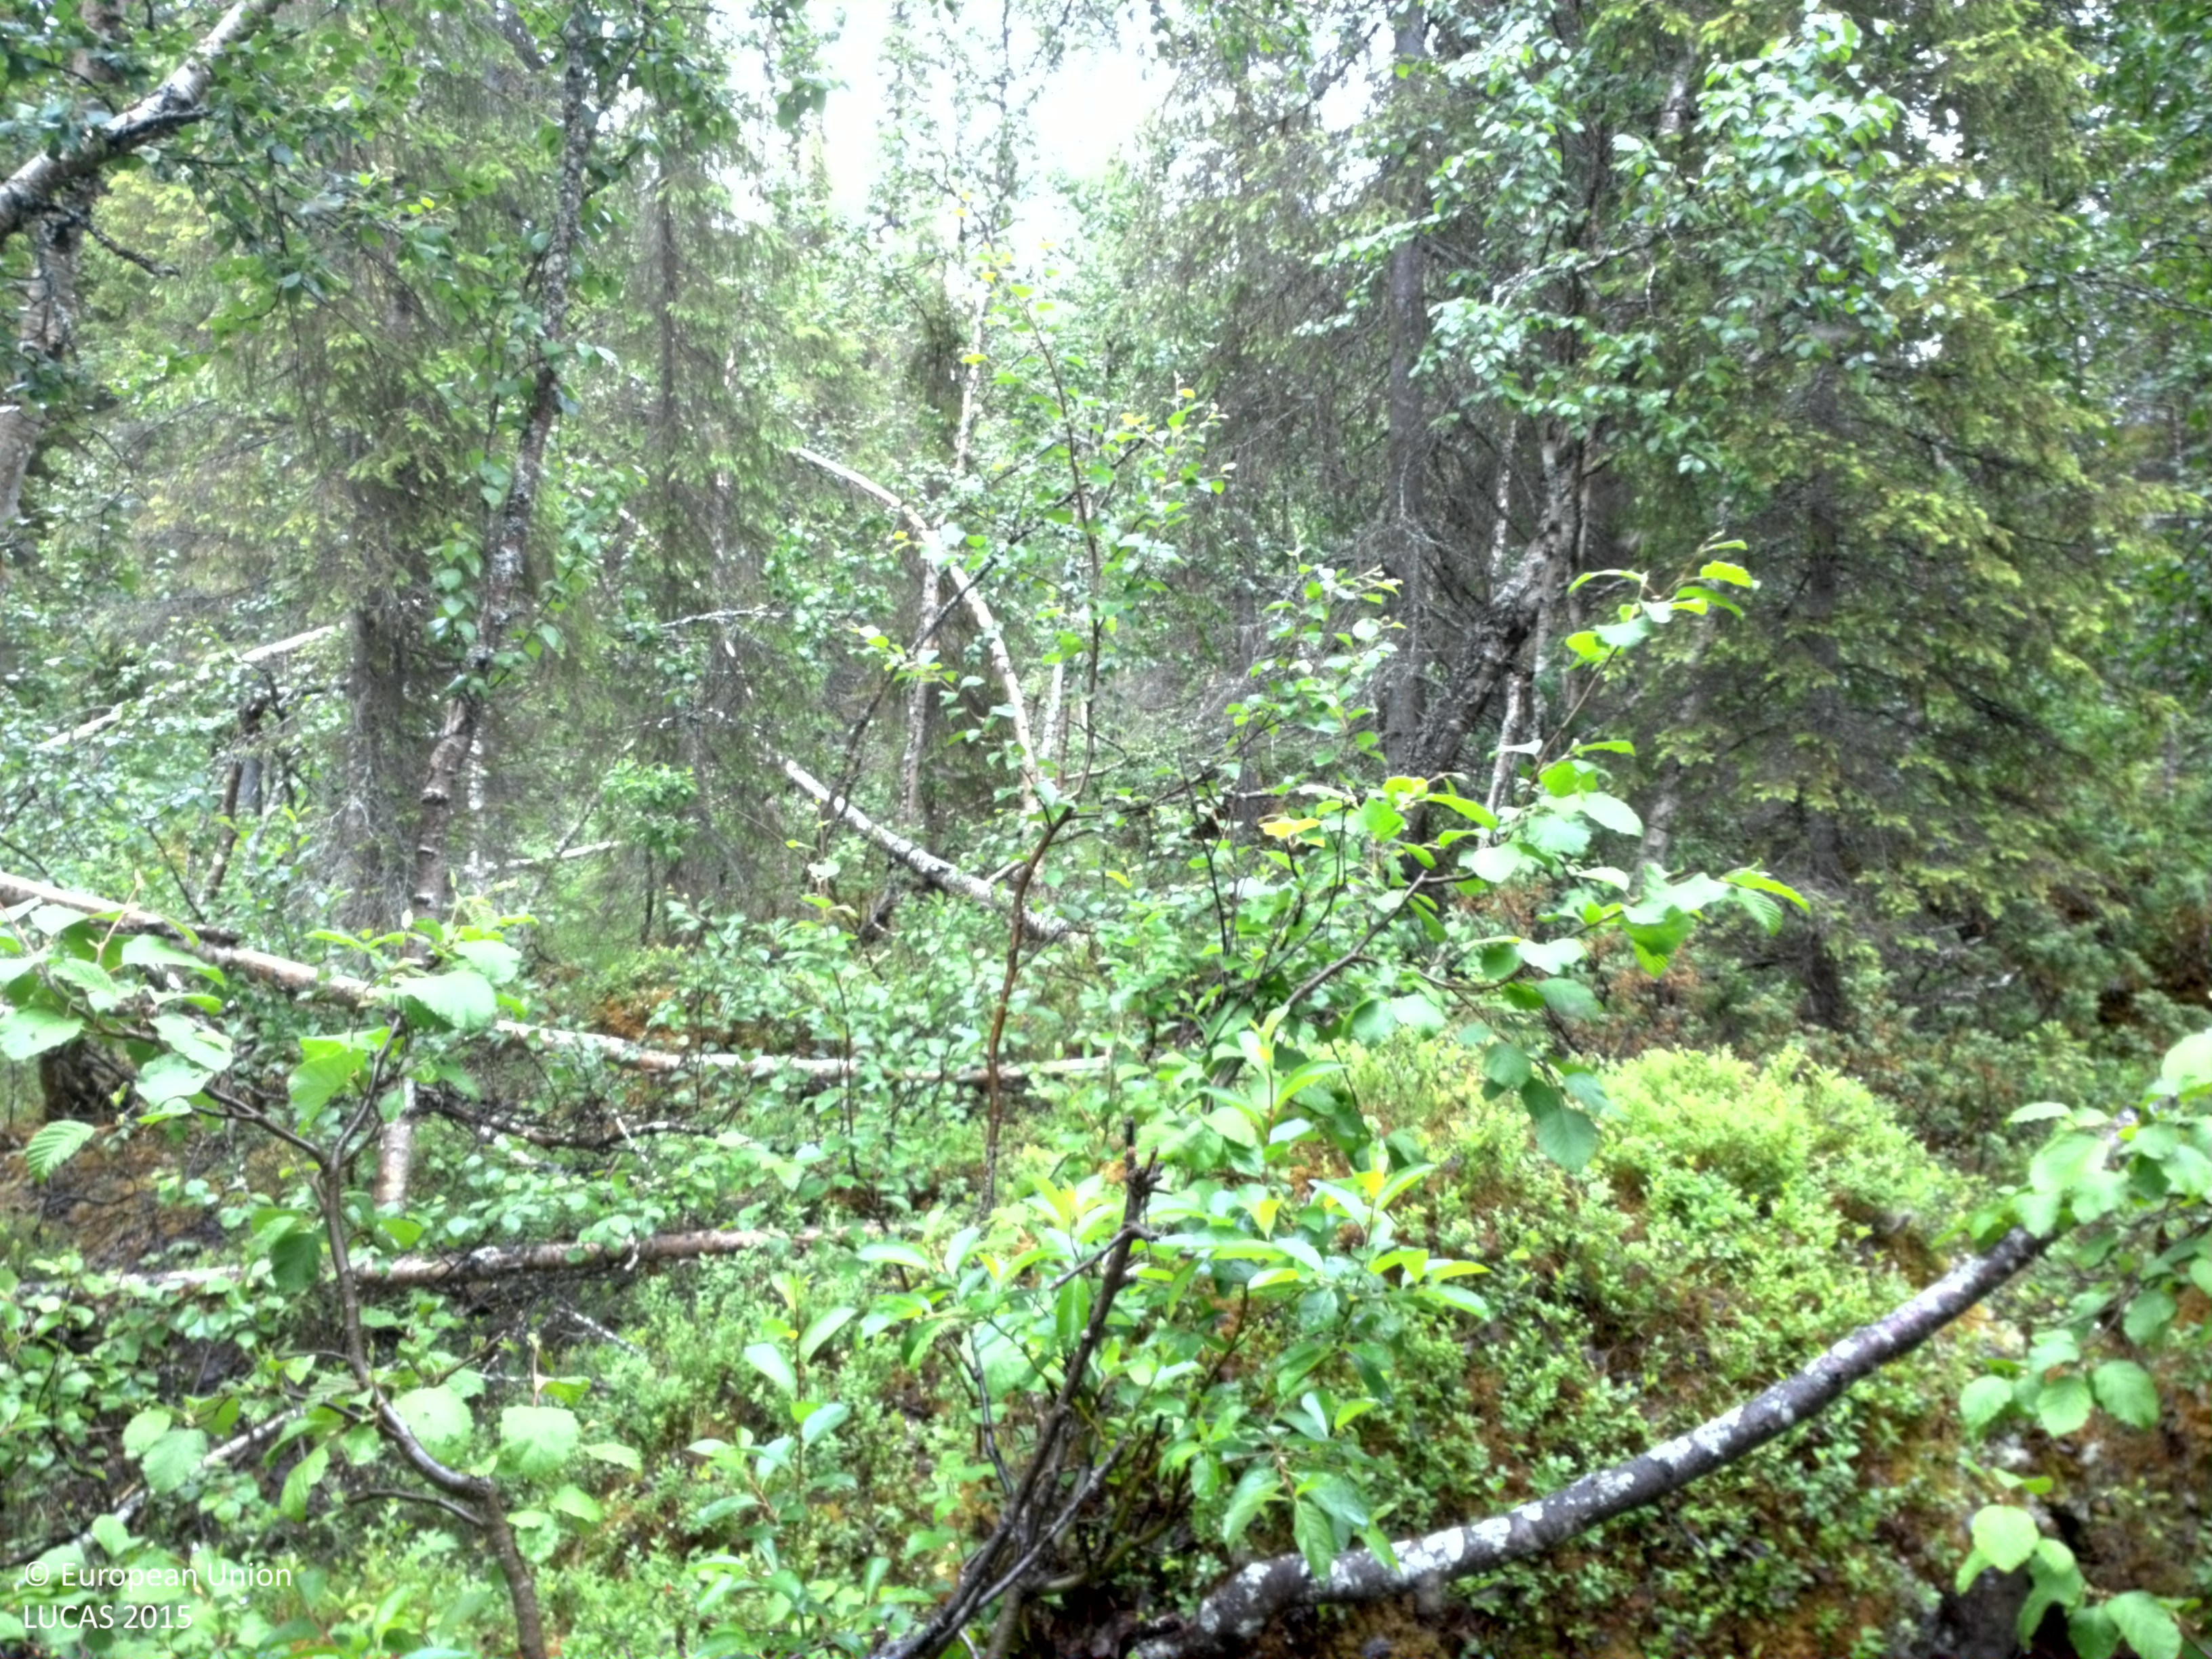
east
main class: Woodland
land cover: Spruce dominated mixed woodland
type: boreal forest
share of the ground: 50 - 75 %
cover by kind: shrubs 35 %, coniferous forest trees 25 %, broadleaved forest trees 25 %, lichens and mosses 10 %, herbaceous plants 5 %
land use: Amenities, museums, leisure
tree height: > 5 m
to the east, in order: Spruce dominated mixed woodland; Rivers and streams; Spruce dominated mixed woodland; Rivers and streams; Spruce dominated mixed woodland; Rivers and streams; Peatbogs
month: July
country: SE
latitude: 65.4717
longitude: 16.2444
